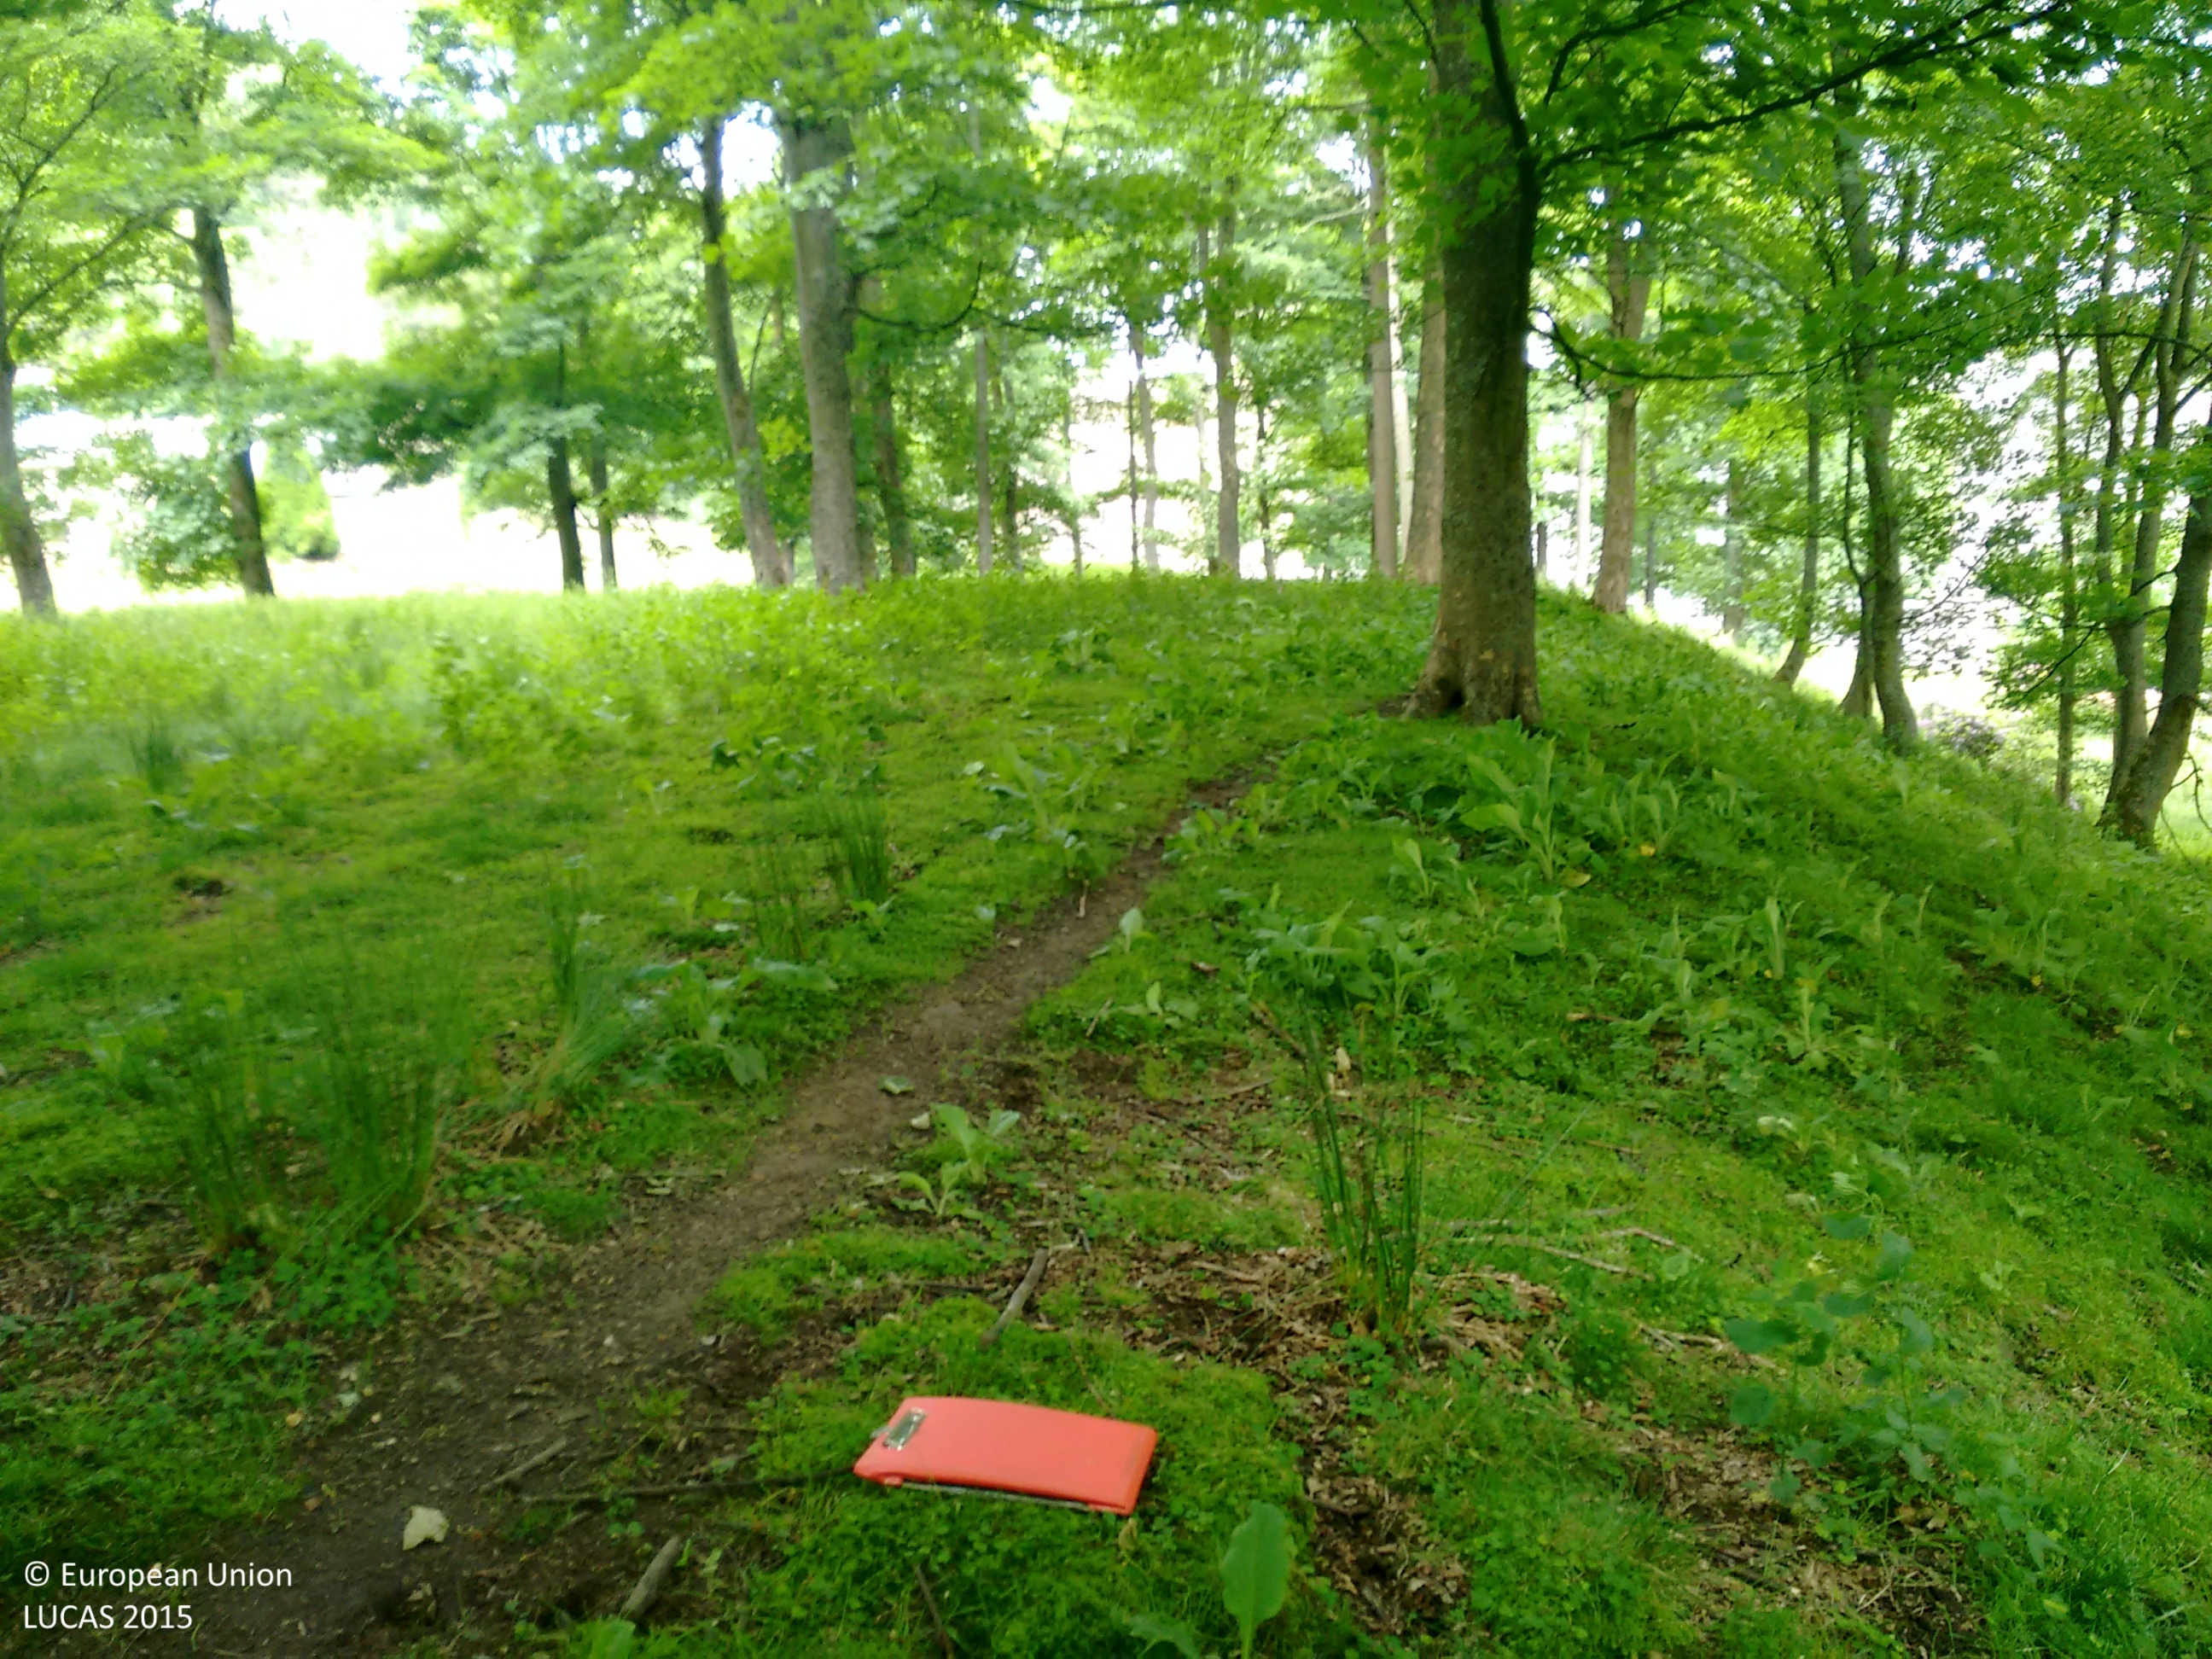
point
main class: Woodland
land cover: Broadleaved woodland
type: mesophytic deciduous forest
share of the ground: > 75 %
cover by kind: broadleaved forest trees 100 %
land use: Amenities, museums, leisure
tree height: > 5 m
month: June
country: GB
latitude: 53.4276
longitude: -1.7474
